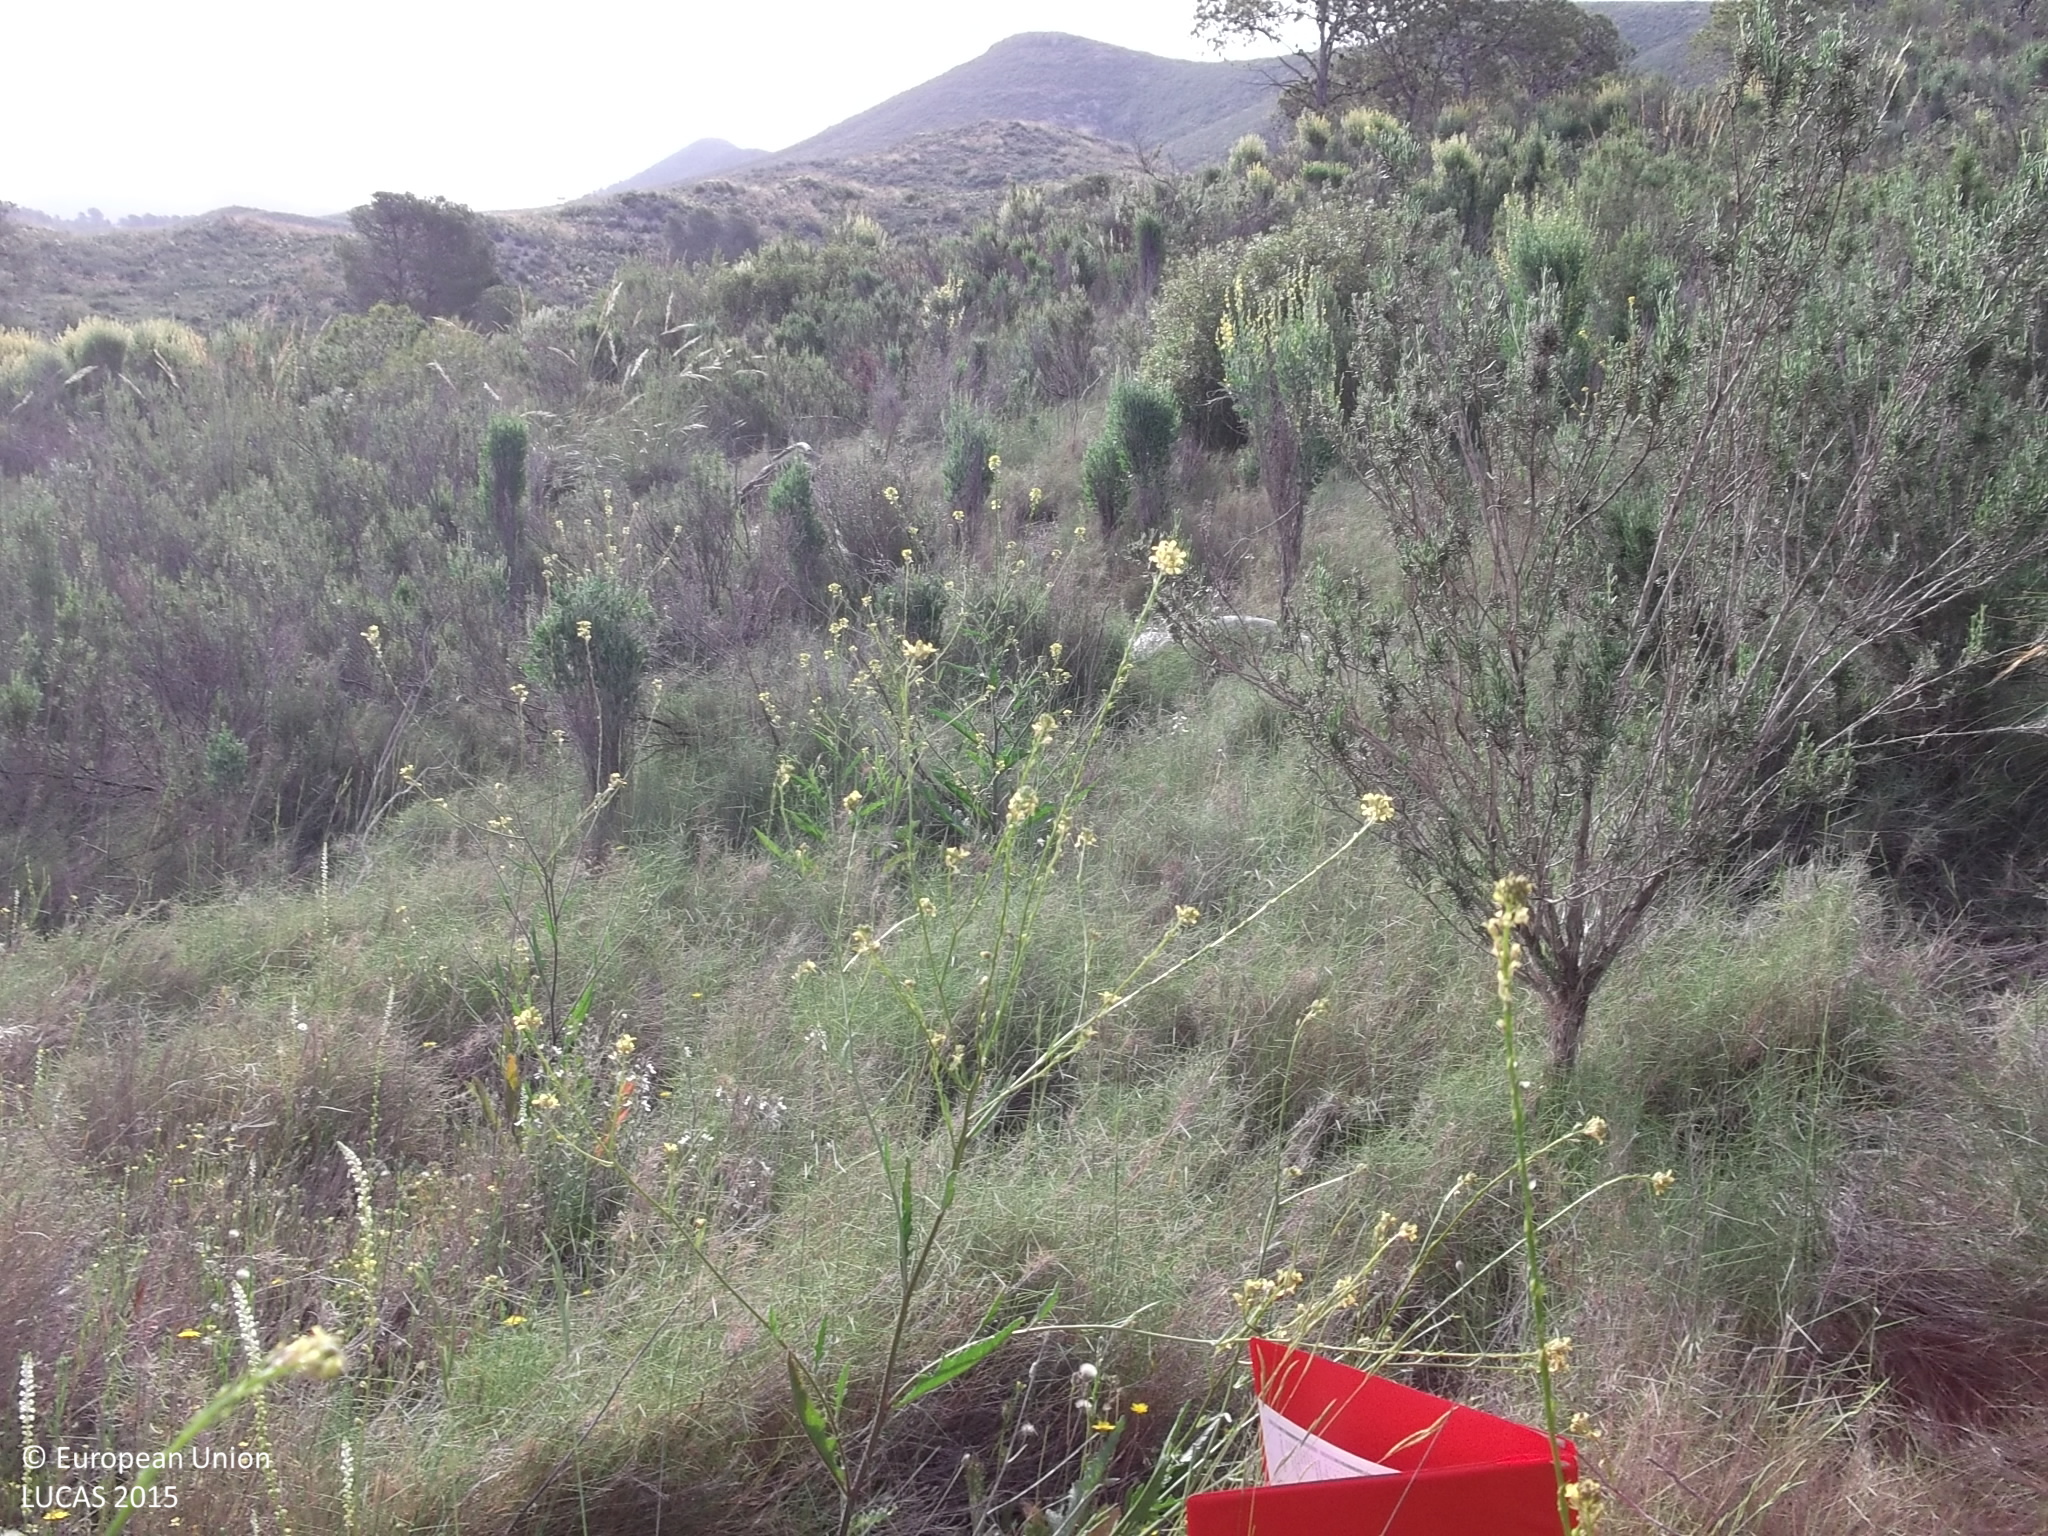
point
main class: Shrubland
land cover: Shrubland with sparse tree cover
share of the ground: 25 - 50 %
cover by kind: shrubs 40 %, herbaceous plants 40 %, consolidated bare surface 15 %, coniferous forest trees 5 %
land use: Semi-natural and natural areas not in use
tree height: > 5 m
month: May
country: ES
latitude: 38.3160
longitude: -1.5992
